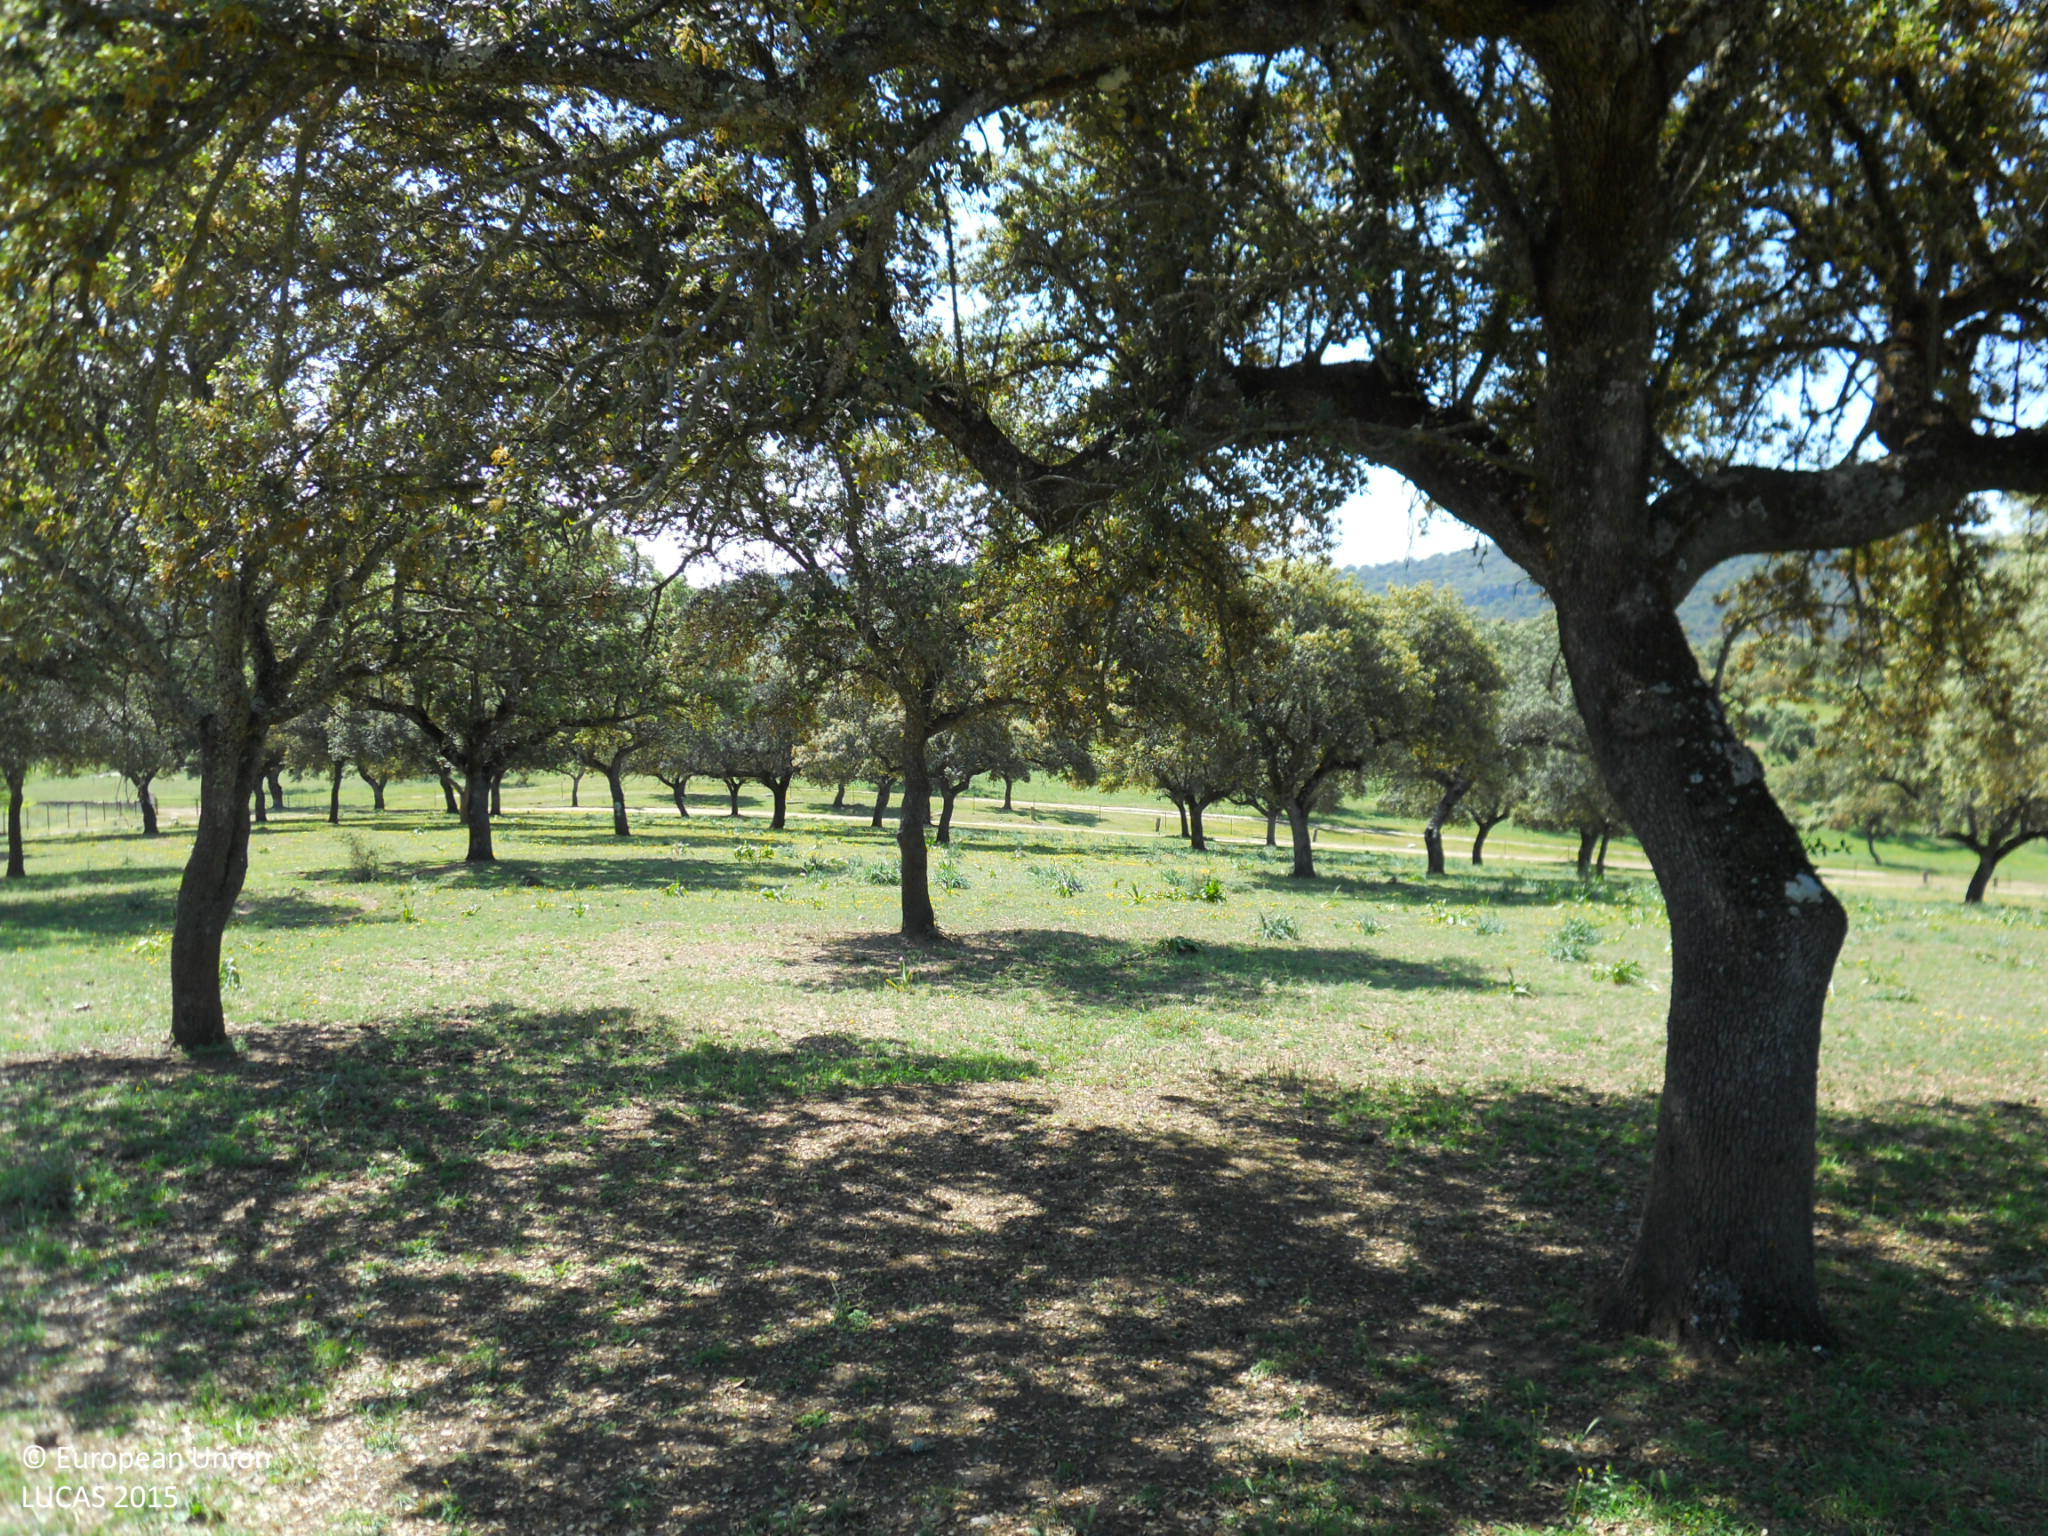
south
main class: Woodland
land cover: Broadleaved woodland
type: broadleaved evergreen forest
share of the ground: > 75 %
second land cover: Grassland without tree/shrub cover
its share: > 75 %
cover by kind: broadleaved forest trees 90 %, herbaceous plants 10 %
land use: Forestry
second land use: Agriculture (excluding fallow land and kitchen gardens)
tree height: > 5 m
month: April
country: ES
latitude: 39.2192
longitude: -6.7619
